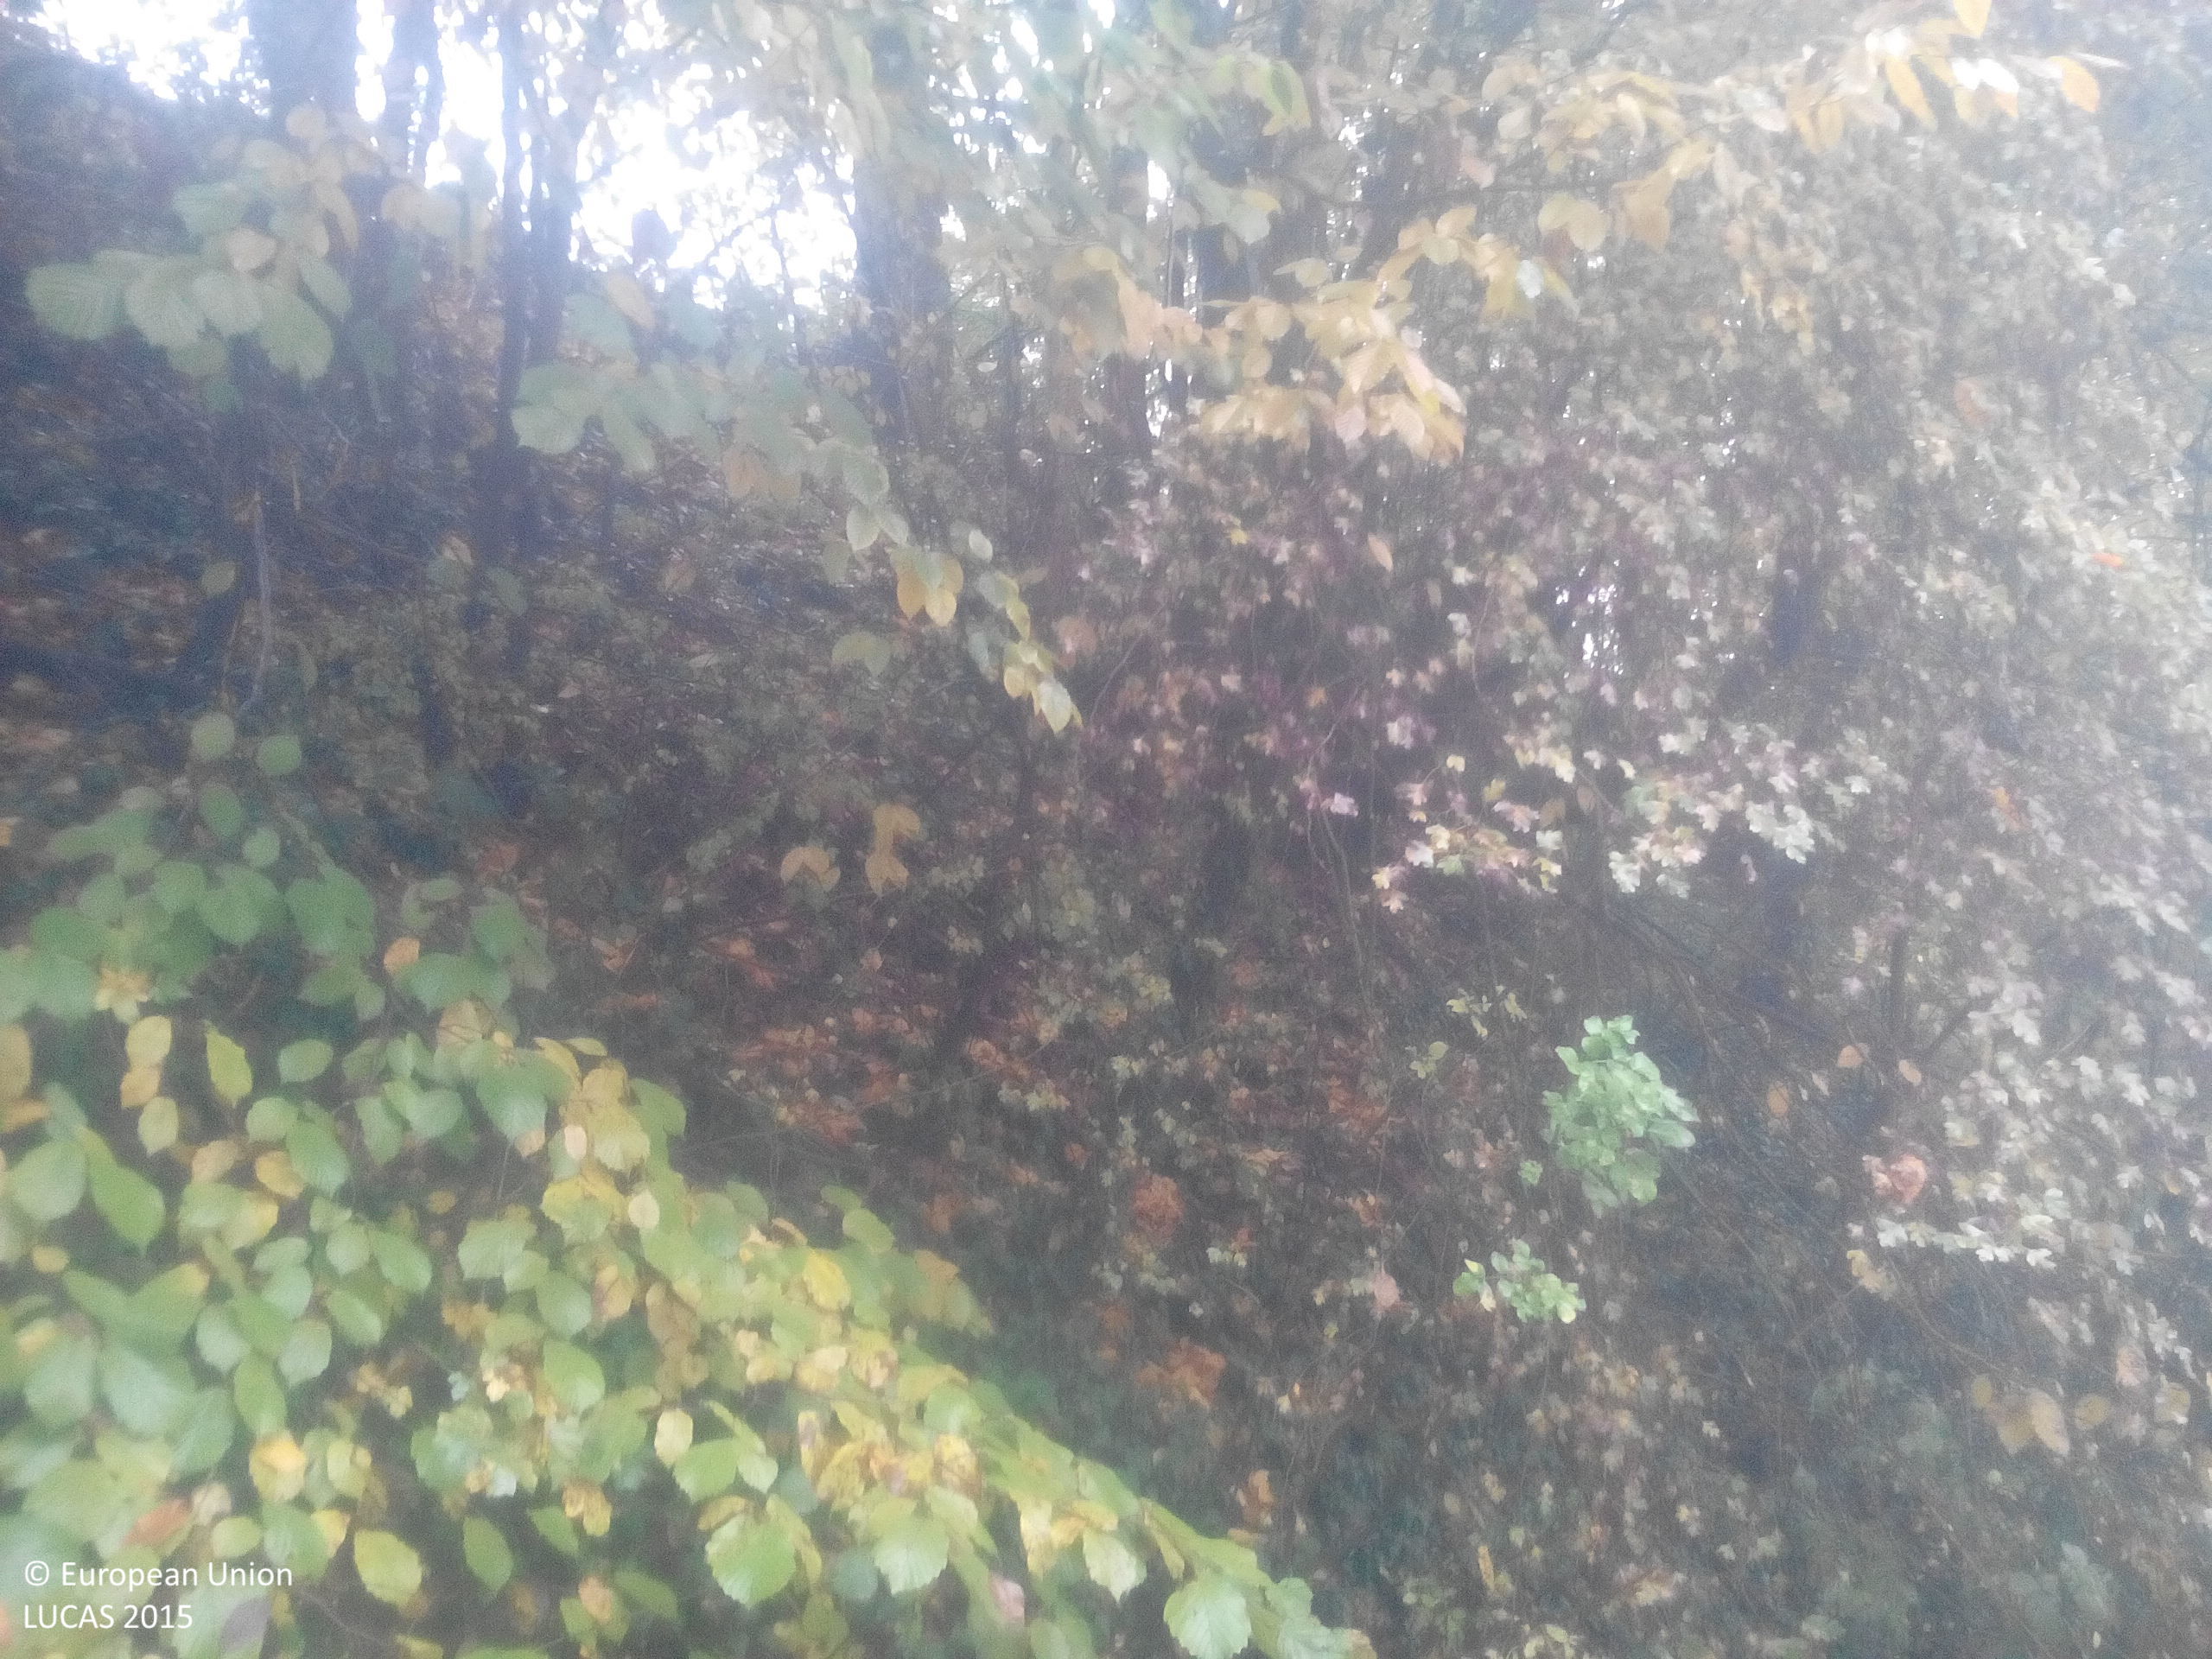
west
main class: Woodland
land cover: Broadleaved woodland
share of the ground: 50 - 75 %
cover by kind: broadleaved forest trees 70 %, herbaceous plants 20 %, shrubs 10 %
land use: Semi-natural and natural areas not in use
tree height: > 5 m
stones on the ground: < 10 %
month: October
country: BG
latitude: 42.9962
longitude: 24.2436
